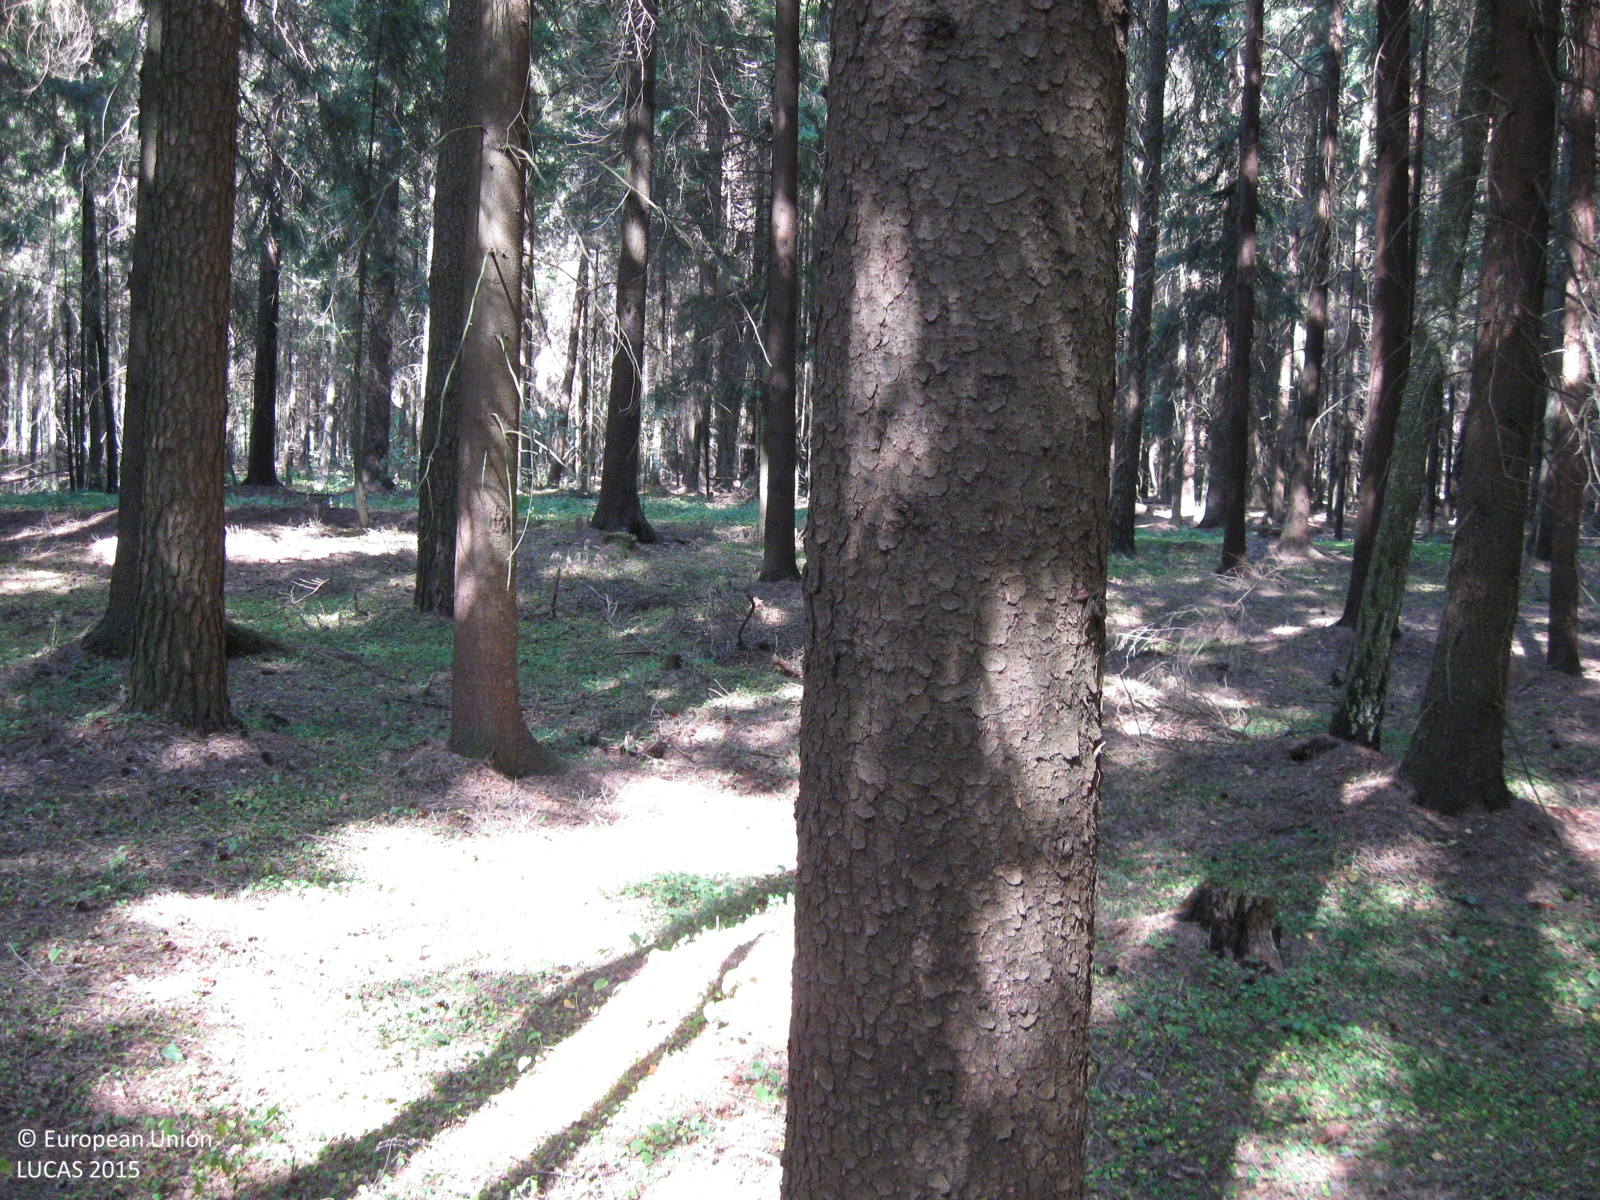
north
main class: Woodland
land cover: Spruce dominated coniferous woodland
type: hemiboreal forest and nemoral coniferous forest and mixed broadleaved-coniferous forest
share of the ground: > 75 %
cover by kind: coniferous forest trees 85 %, broadleaved forest trees 10 %, herbaceous plants 5 %
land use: Forestry
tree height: > 5 m
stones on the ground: < 10 %
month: August
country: LT
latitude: 55.2660
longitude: 22.4782
